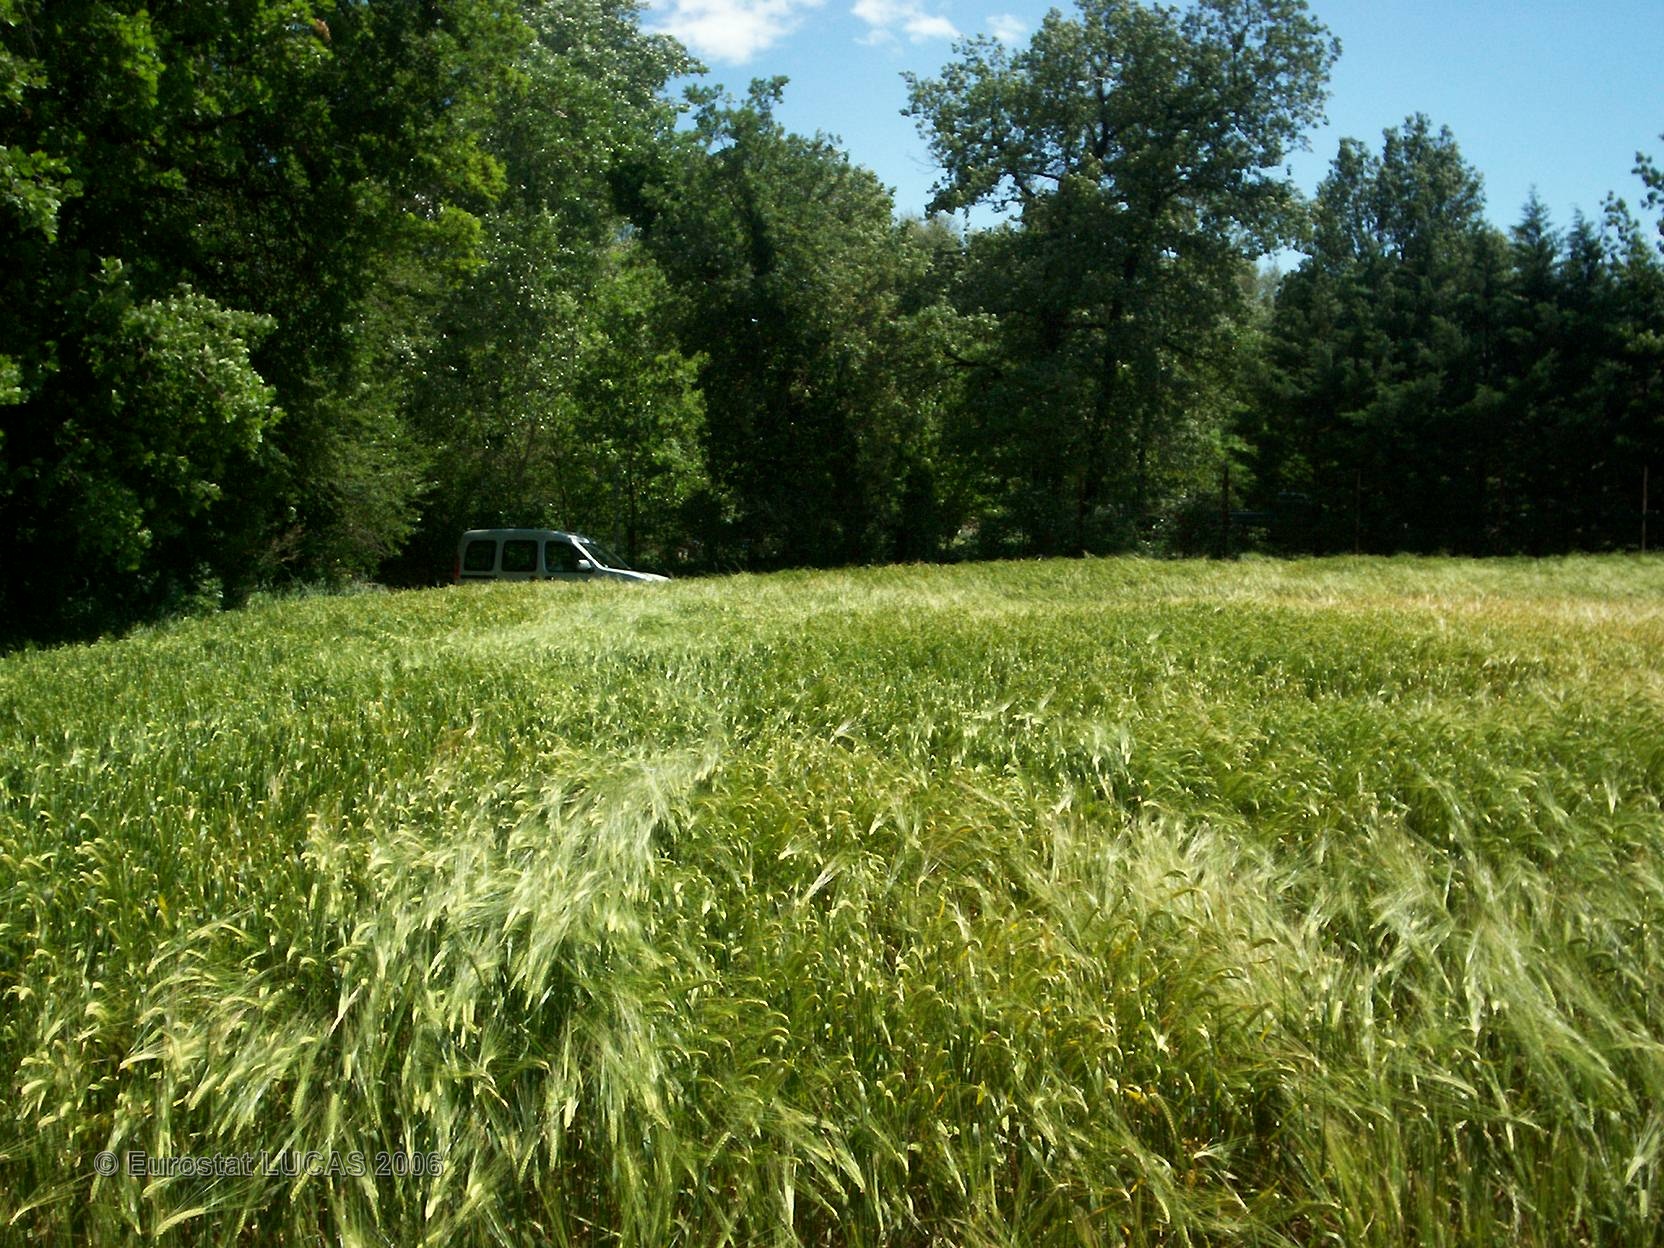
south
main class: Cropland
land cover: Barley
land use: Agriculture (excluding fallow land and kitchen gardens)
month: May
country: FR
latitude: 44.5471
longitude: 4.8335
